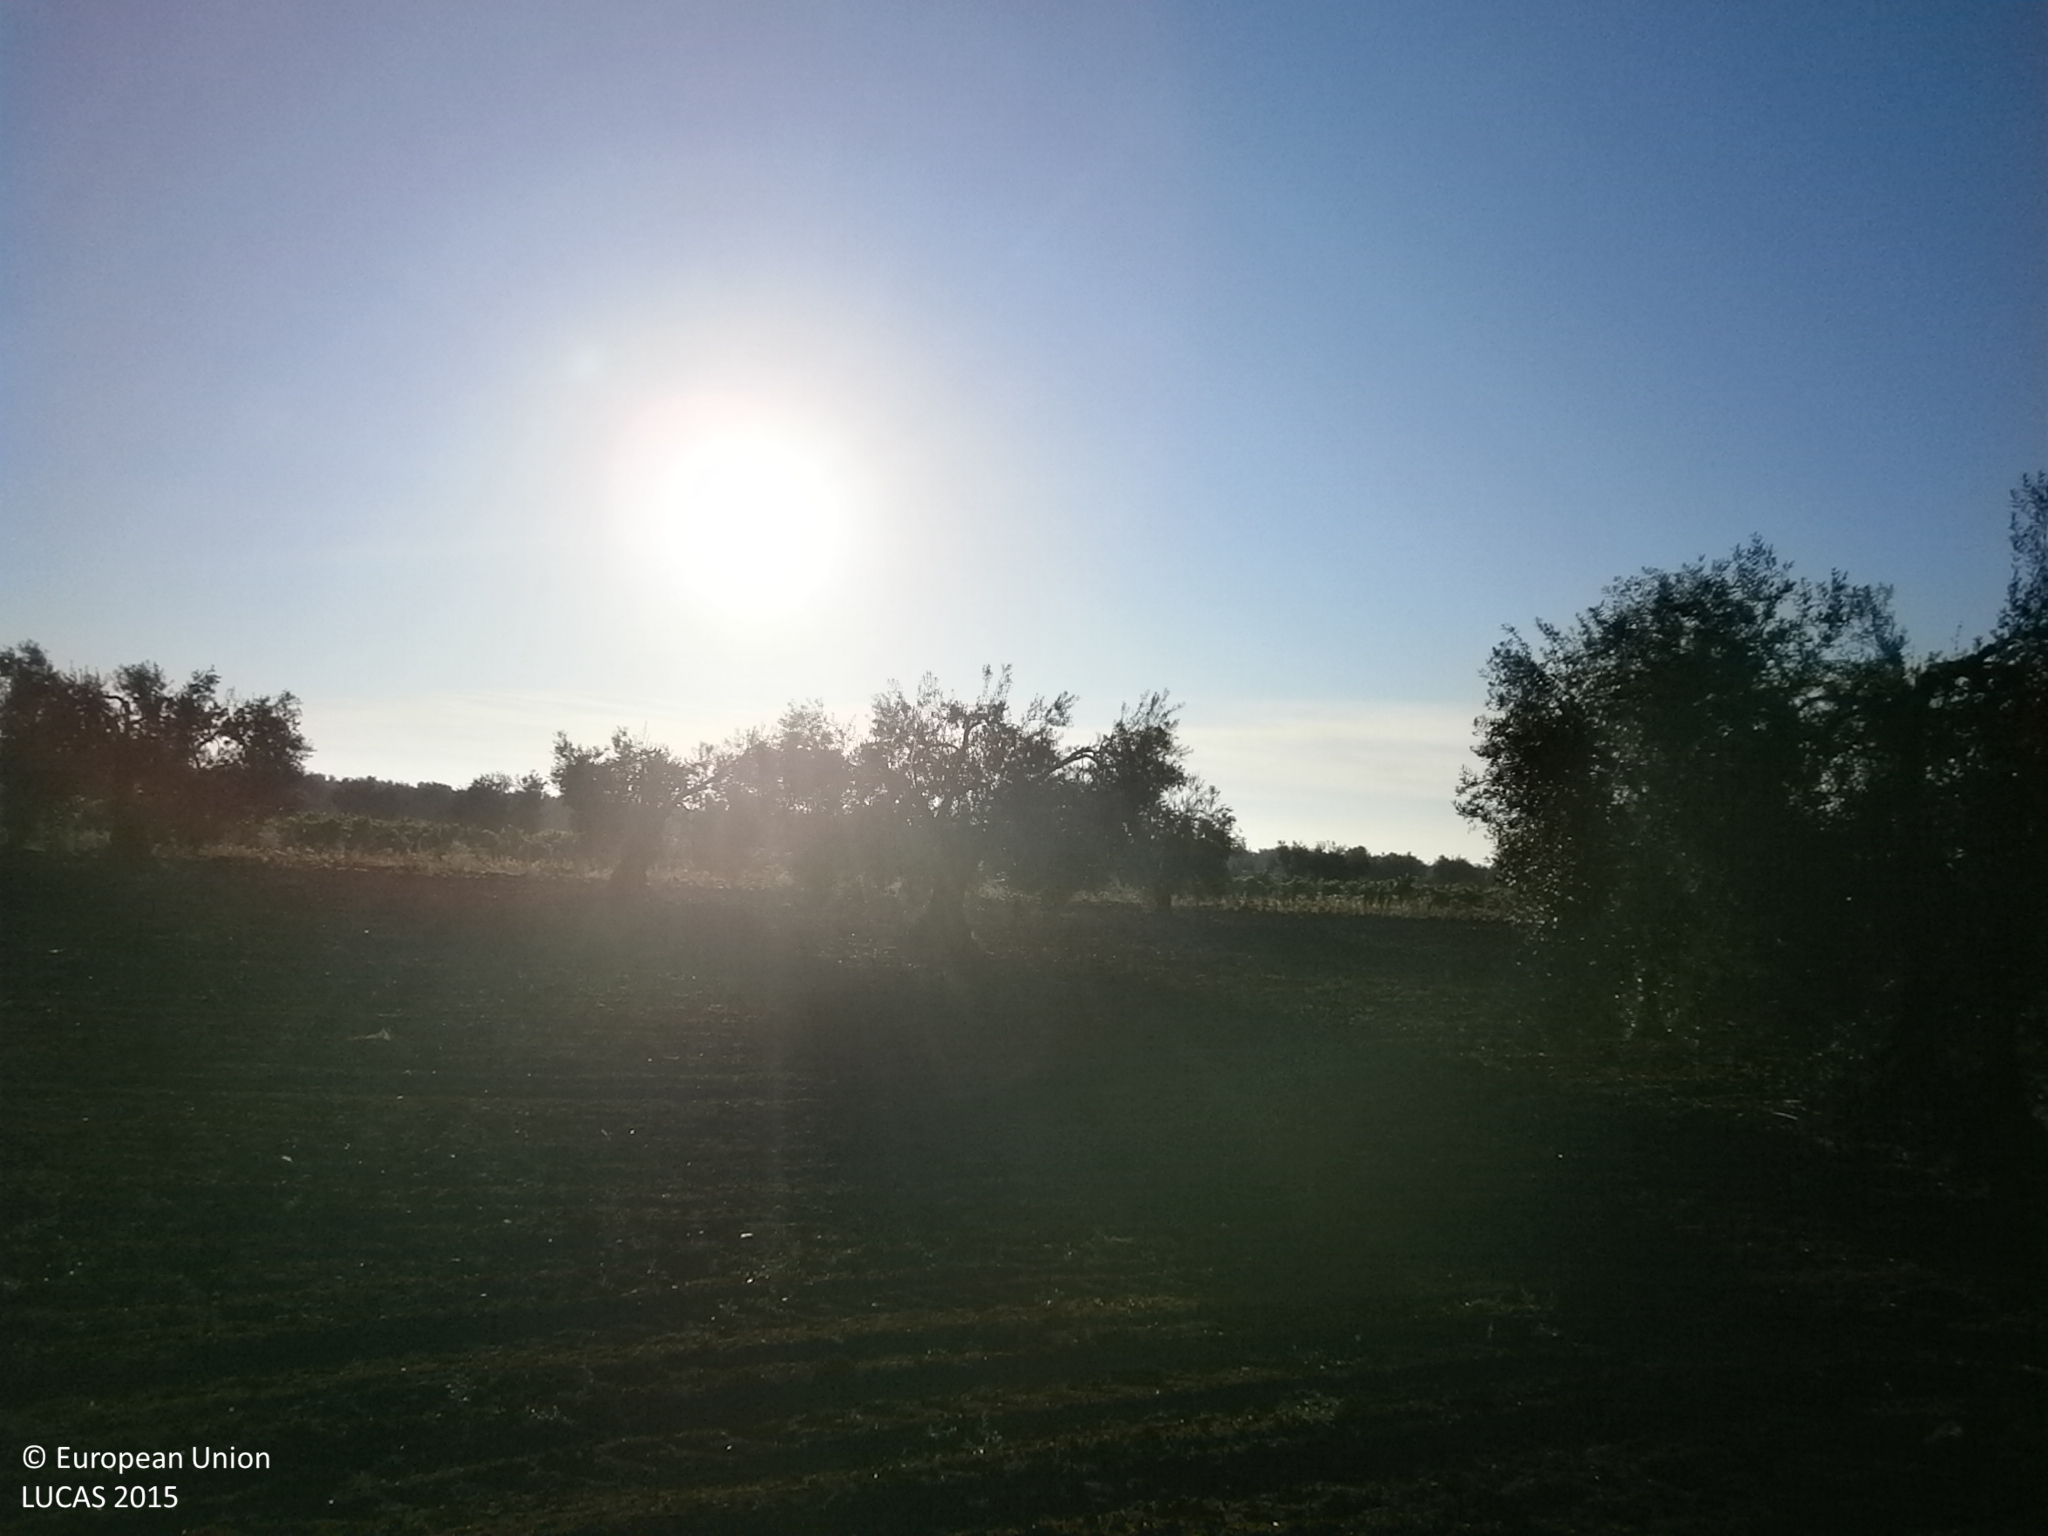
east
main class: Cropland
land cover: Olive groves
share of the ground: 10 - 25 %
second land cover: Other bare soil
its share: > 75 %
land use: Agriculture (excluding fallow land and kitchen gardens)
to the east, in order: Olive groves; Other bare soil; Vineyards; Lines of trees; Tracks; Vineyards; Lines of trees; Olive groves
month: June
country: ES
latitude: 38.7467
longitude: -6.4056
